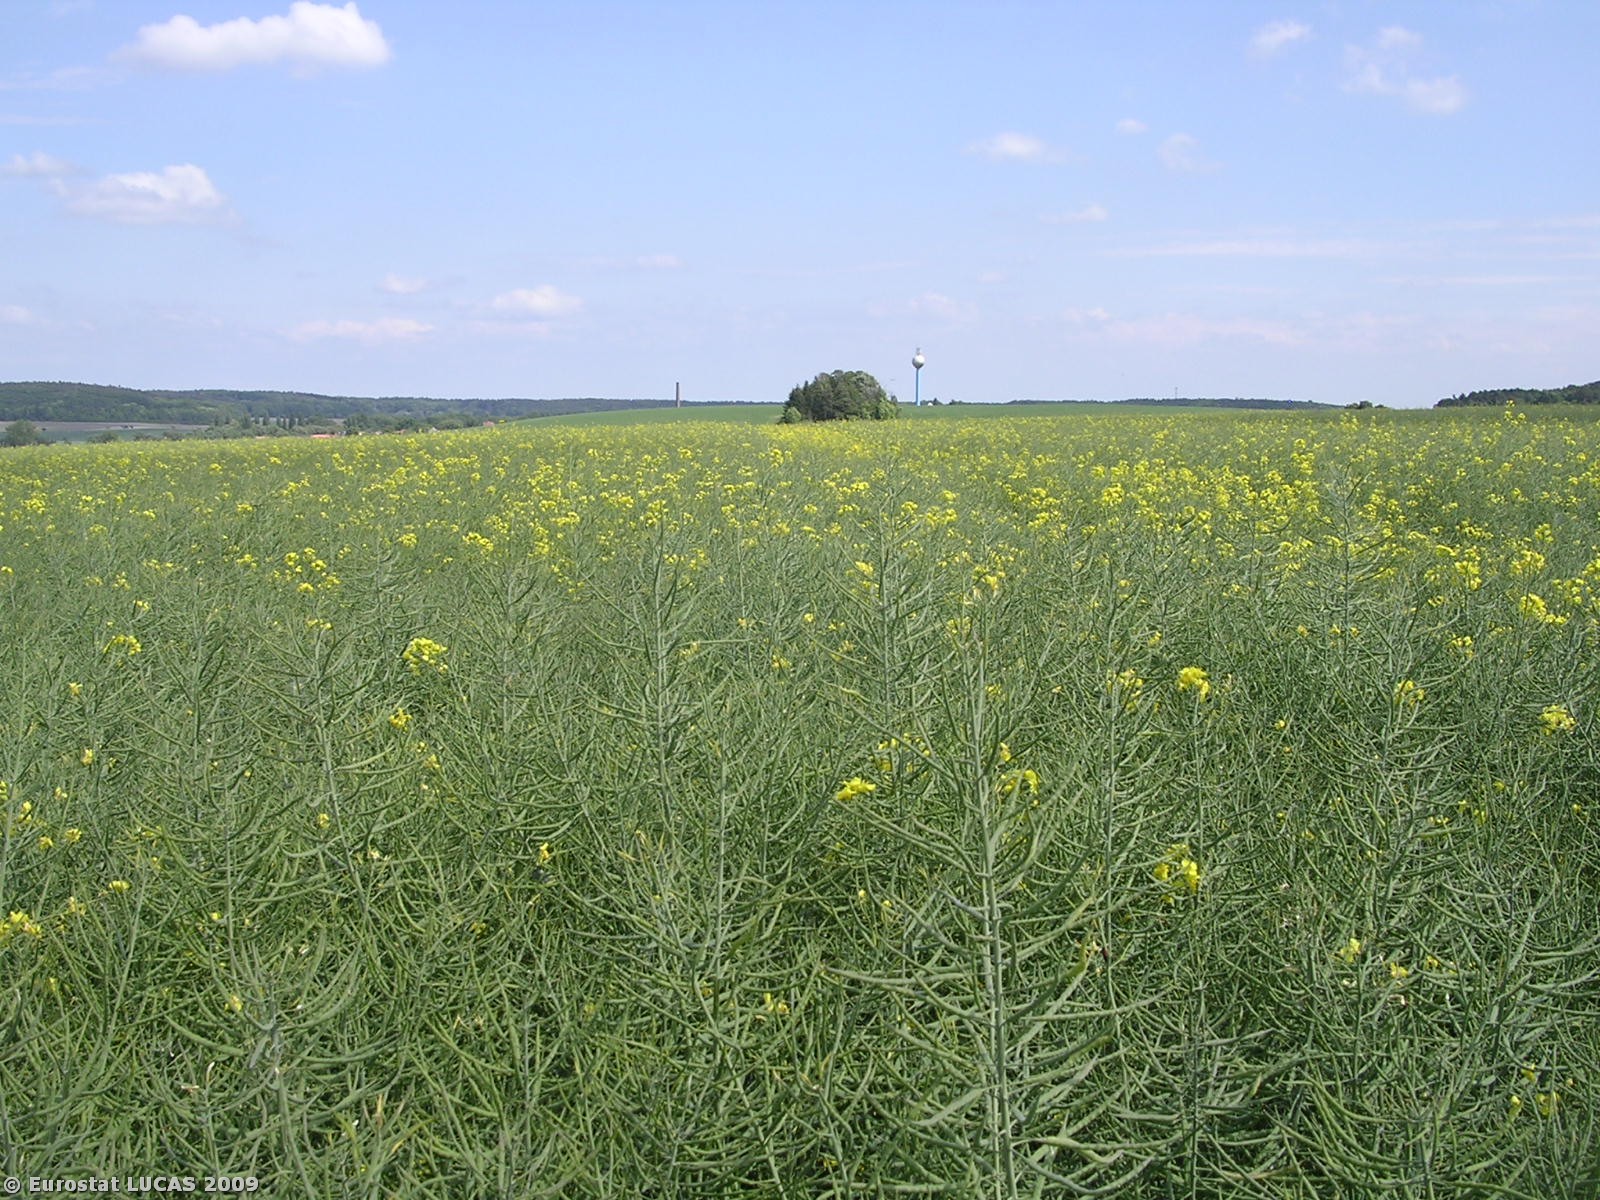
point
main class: Cropland
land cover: Rape and turnip rape
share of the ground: > 75 %
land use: Agriculture (excluding fallow land and kitchen gardens)
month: May
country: CZ
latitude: 50.2759
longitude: 14.9278
